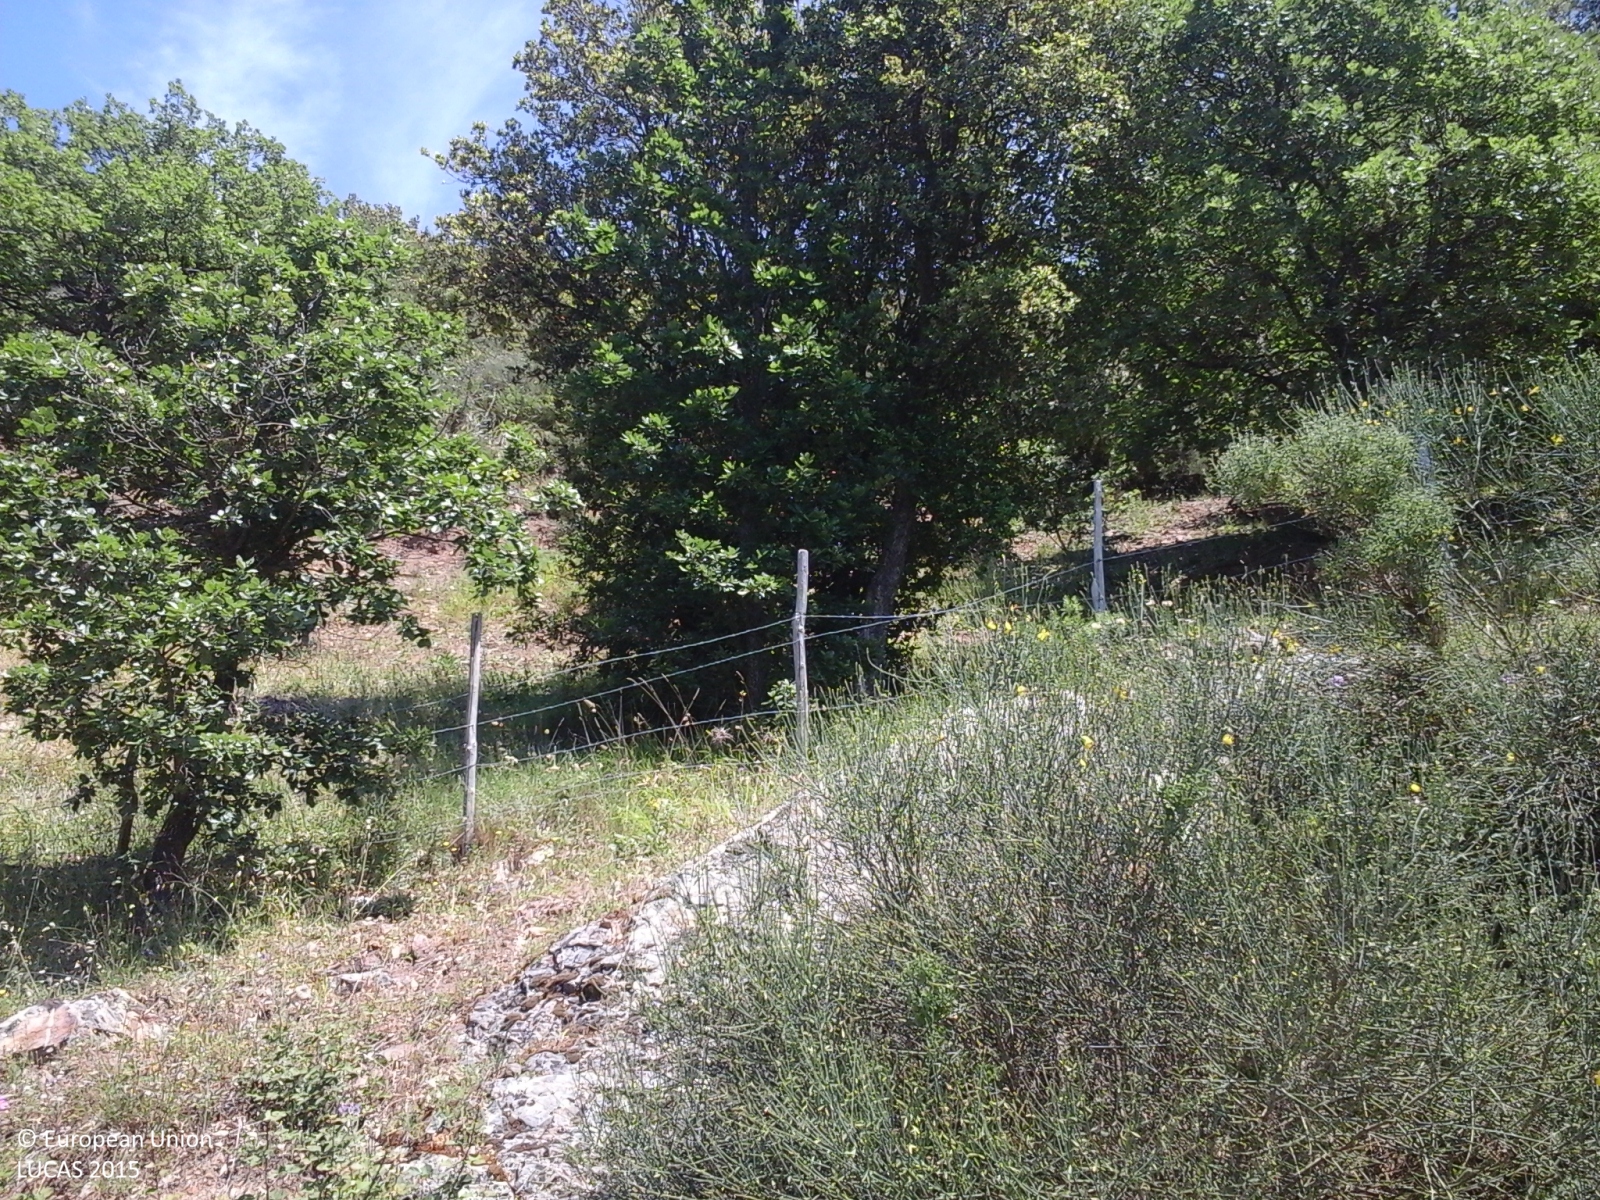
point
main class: Shrubland
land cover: Shrubland with sparse tree cover
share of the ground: > 75 %
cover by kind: shrubs 55 %, herbaceous plants 40 %, broadleaved forest trees 5 %
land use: Agriculture (excluding fallow land and kitchen gardens)
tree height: < 5 m
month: June
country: IT
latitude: 37.9555
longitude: 13.9669
